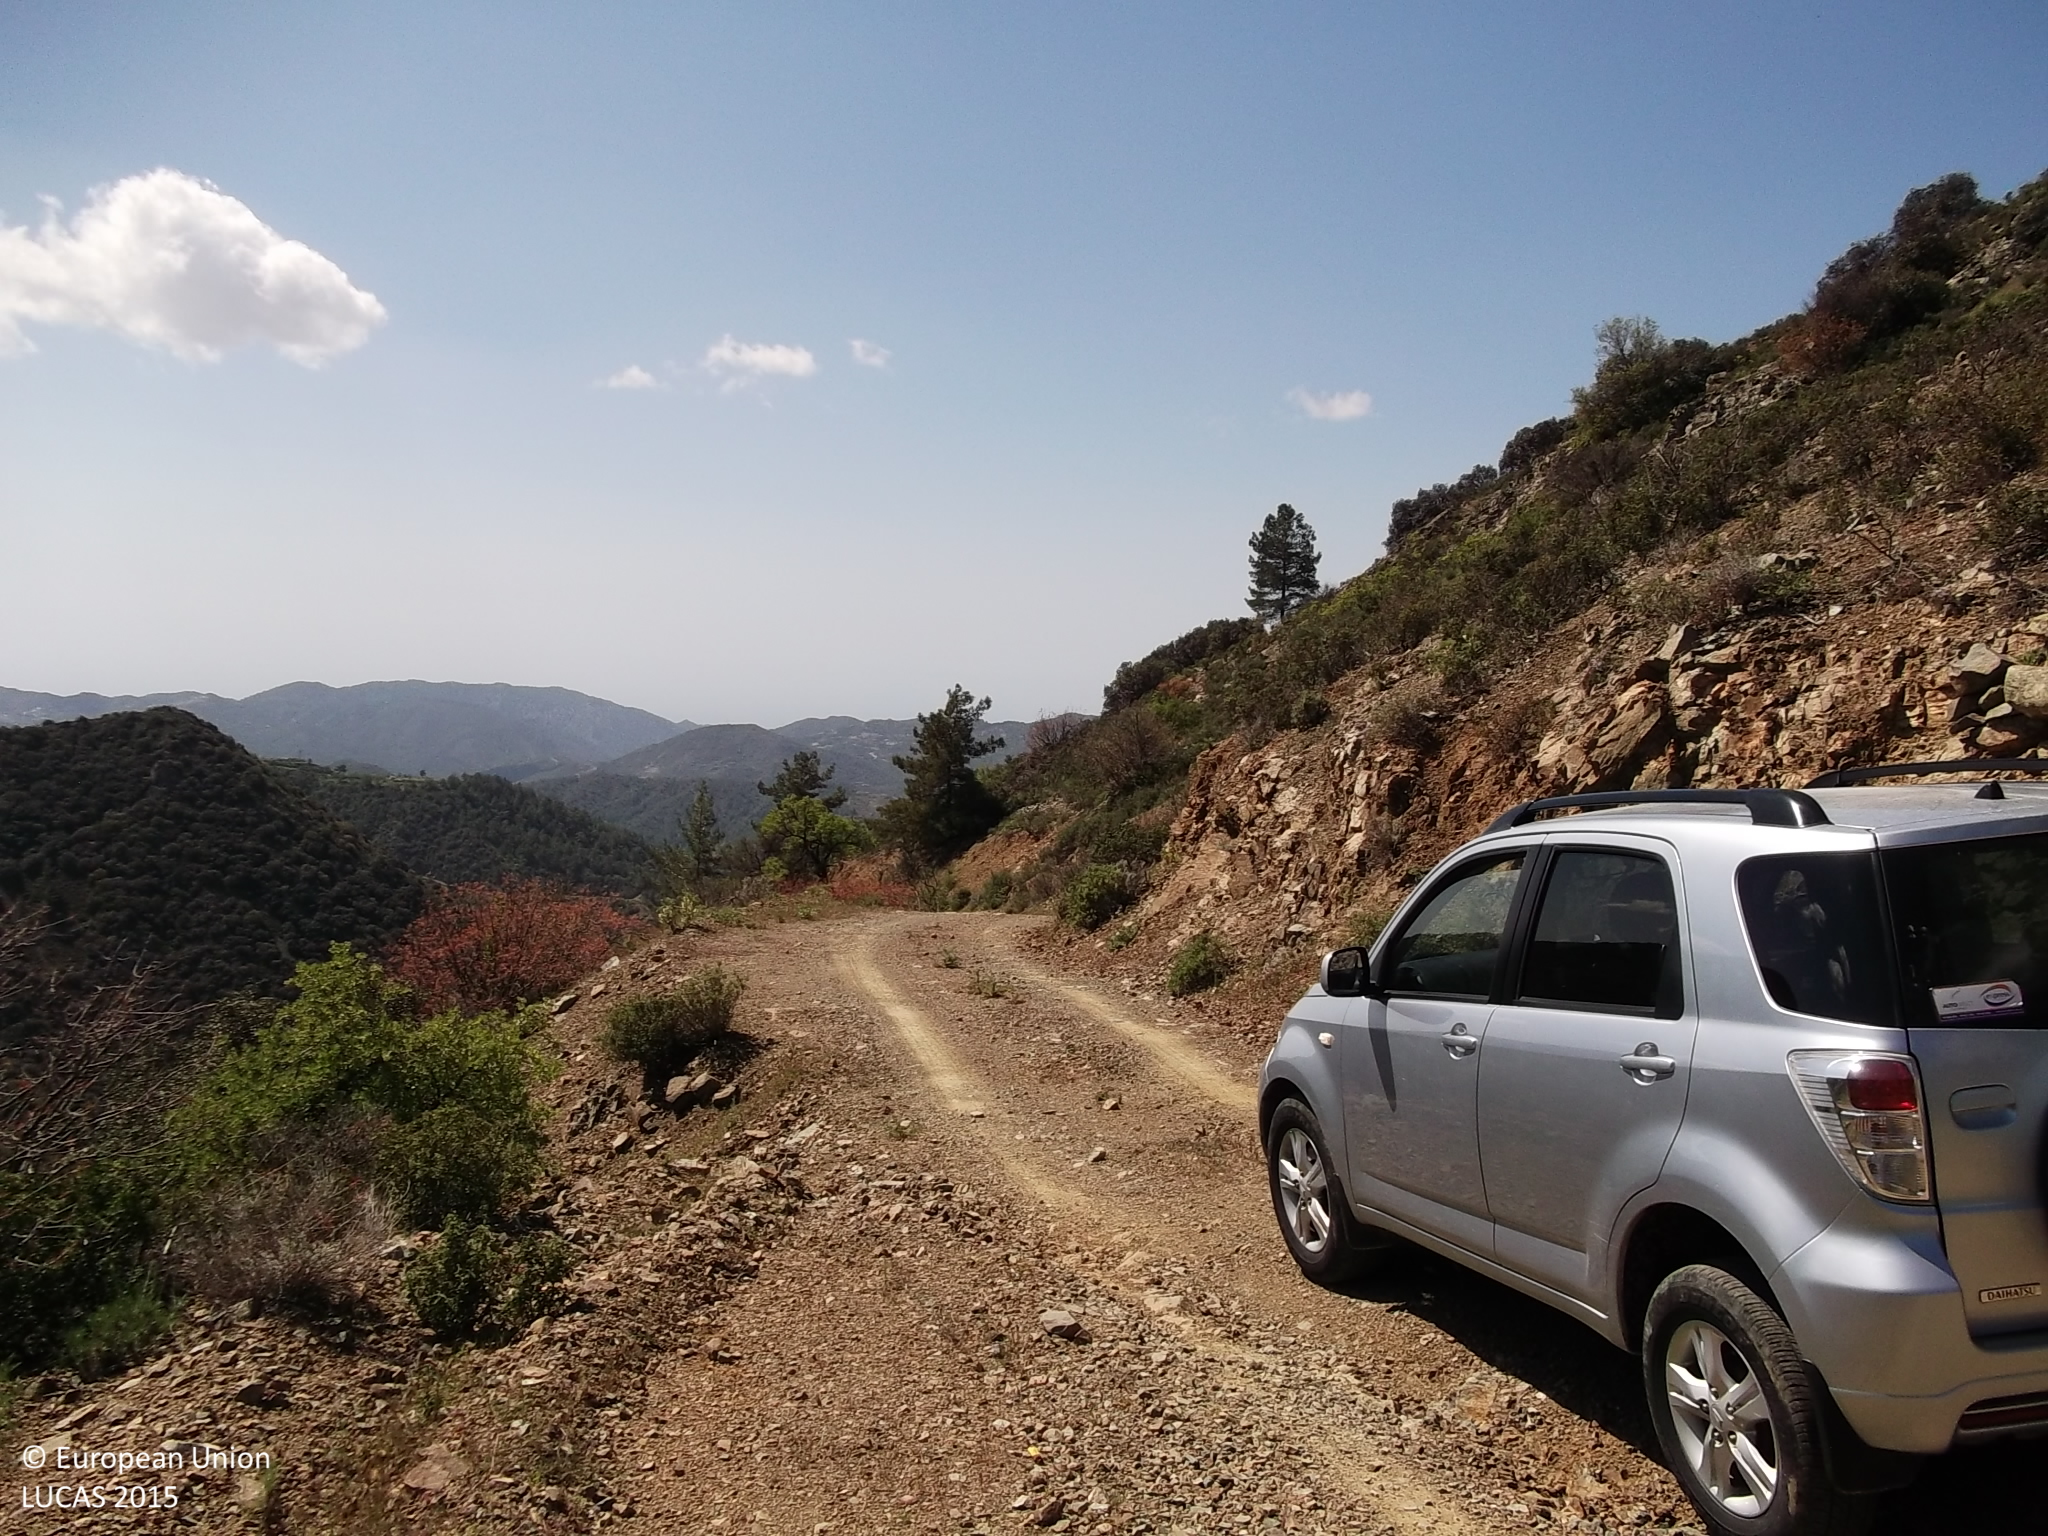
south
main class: Woodland
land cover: Broadleaved woodland
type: broadleaved evergreen forest
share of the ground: 25 - 50 %
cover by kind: broadleaved forest trees 45 %, shrubs 25 %, herbaceous plants 10 %, consolidated bare surface 10 %, unconsolidated bare surface 10 %
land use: Semi-natural and natural areas not in use
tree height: > 5 m
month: April
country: CY
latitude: 34.8994
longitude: 33.1008
